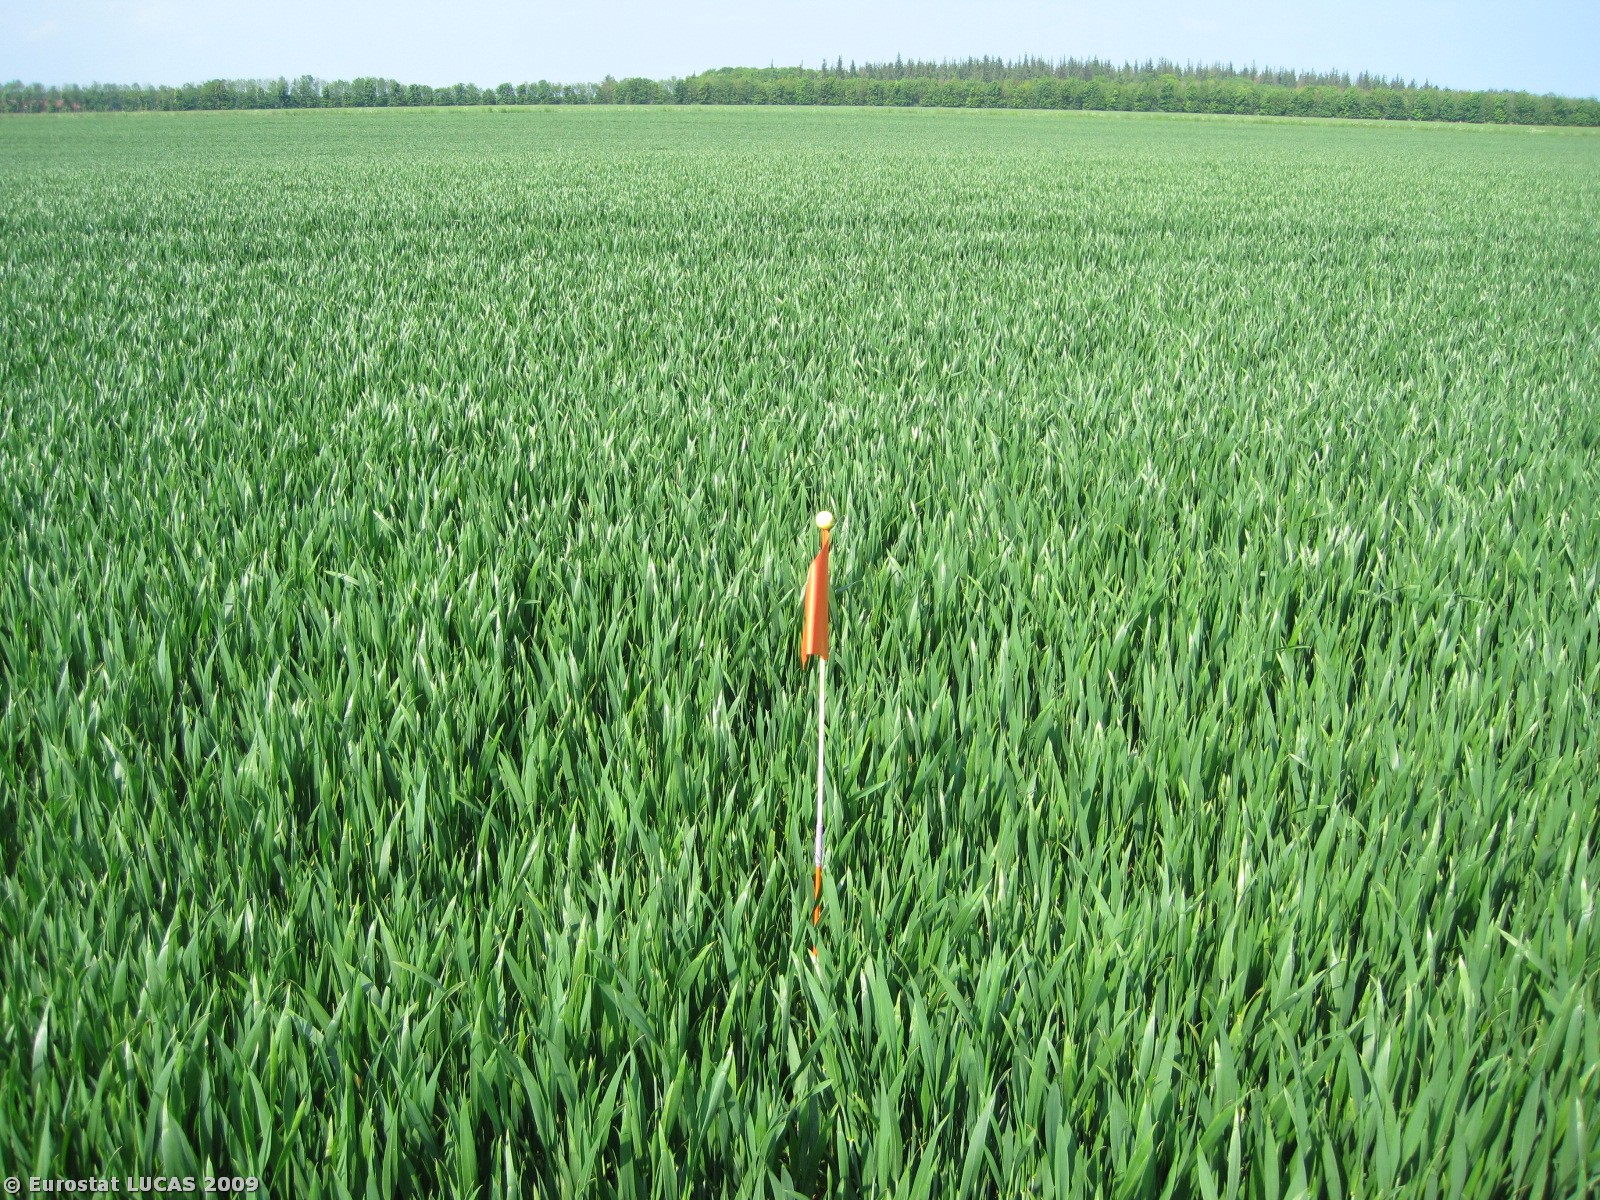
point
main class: Cropland
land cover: Common wheat
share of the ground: > 75 %
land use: Agriculture (excluding fallow land and kitchen gardens)
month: May
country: DK
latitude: 56.6728
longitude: 10.2770
